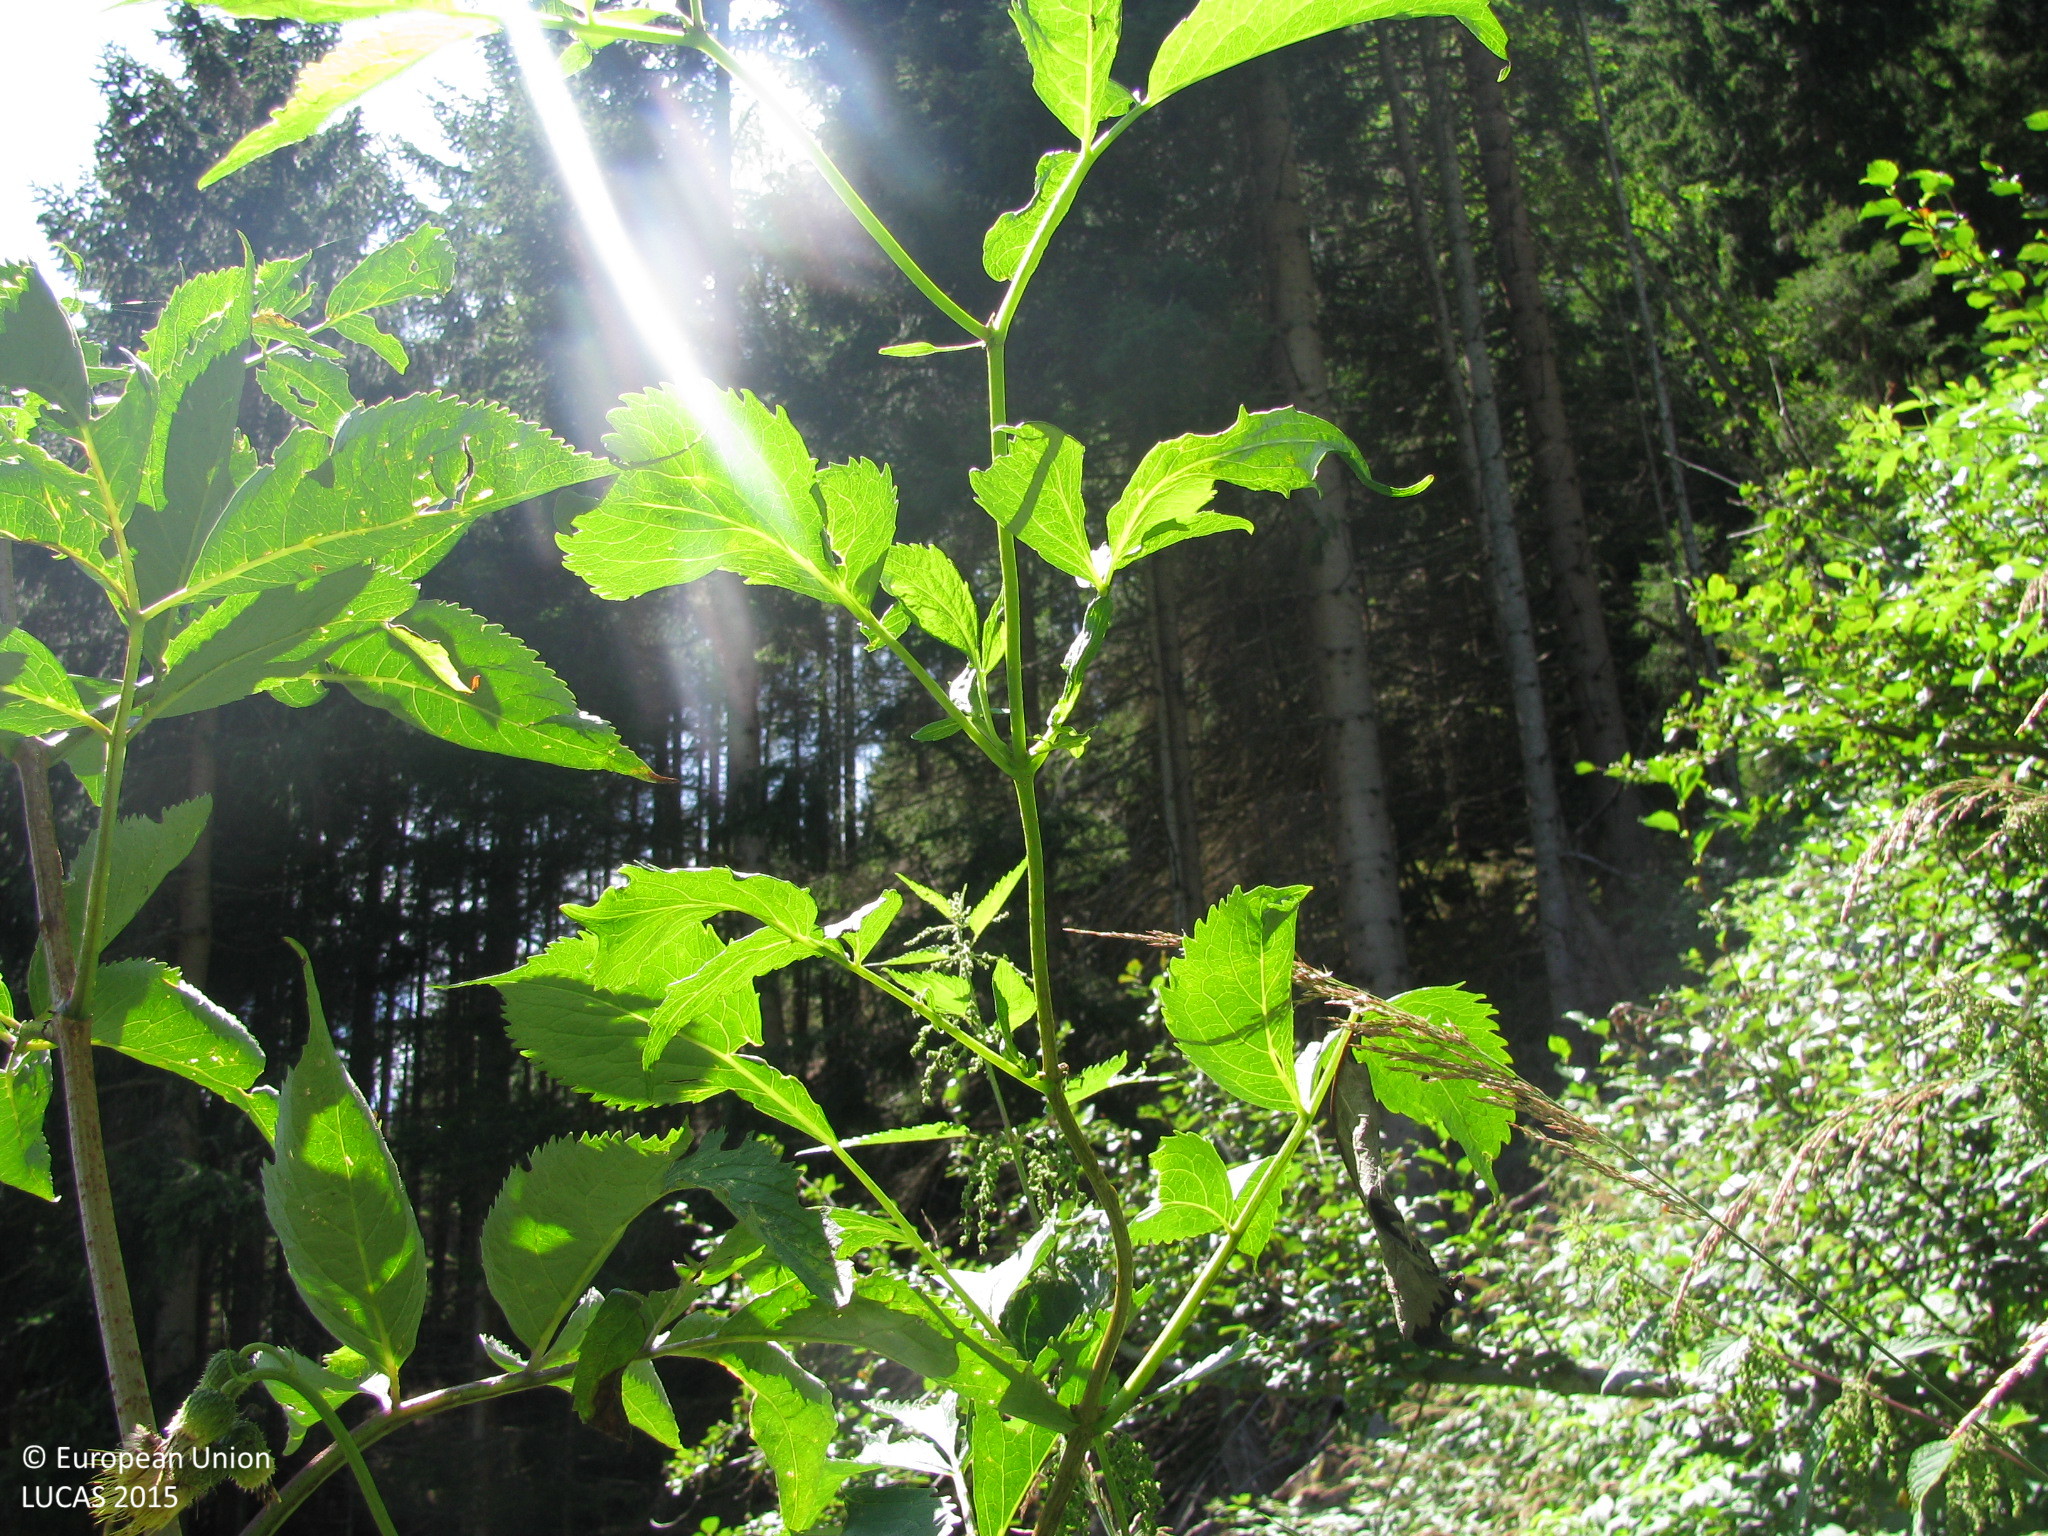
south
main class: Shrubland
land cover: Shrubland with sparse tree cover
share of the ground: > 75 %
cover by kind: shrubs 70 %, herbaceous plants 25 %, coniferous forest trees 5 %
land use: Forestry
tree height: < 5 m
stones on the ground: 25 - 50 %
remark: Clear cut
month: July
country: AT
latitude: 46.8547
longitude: 12.8174
